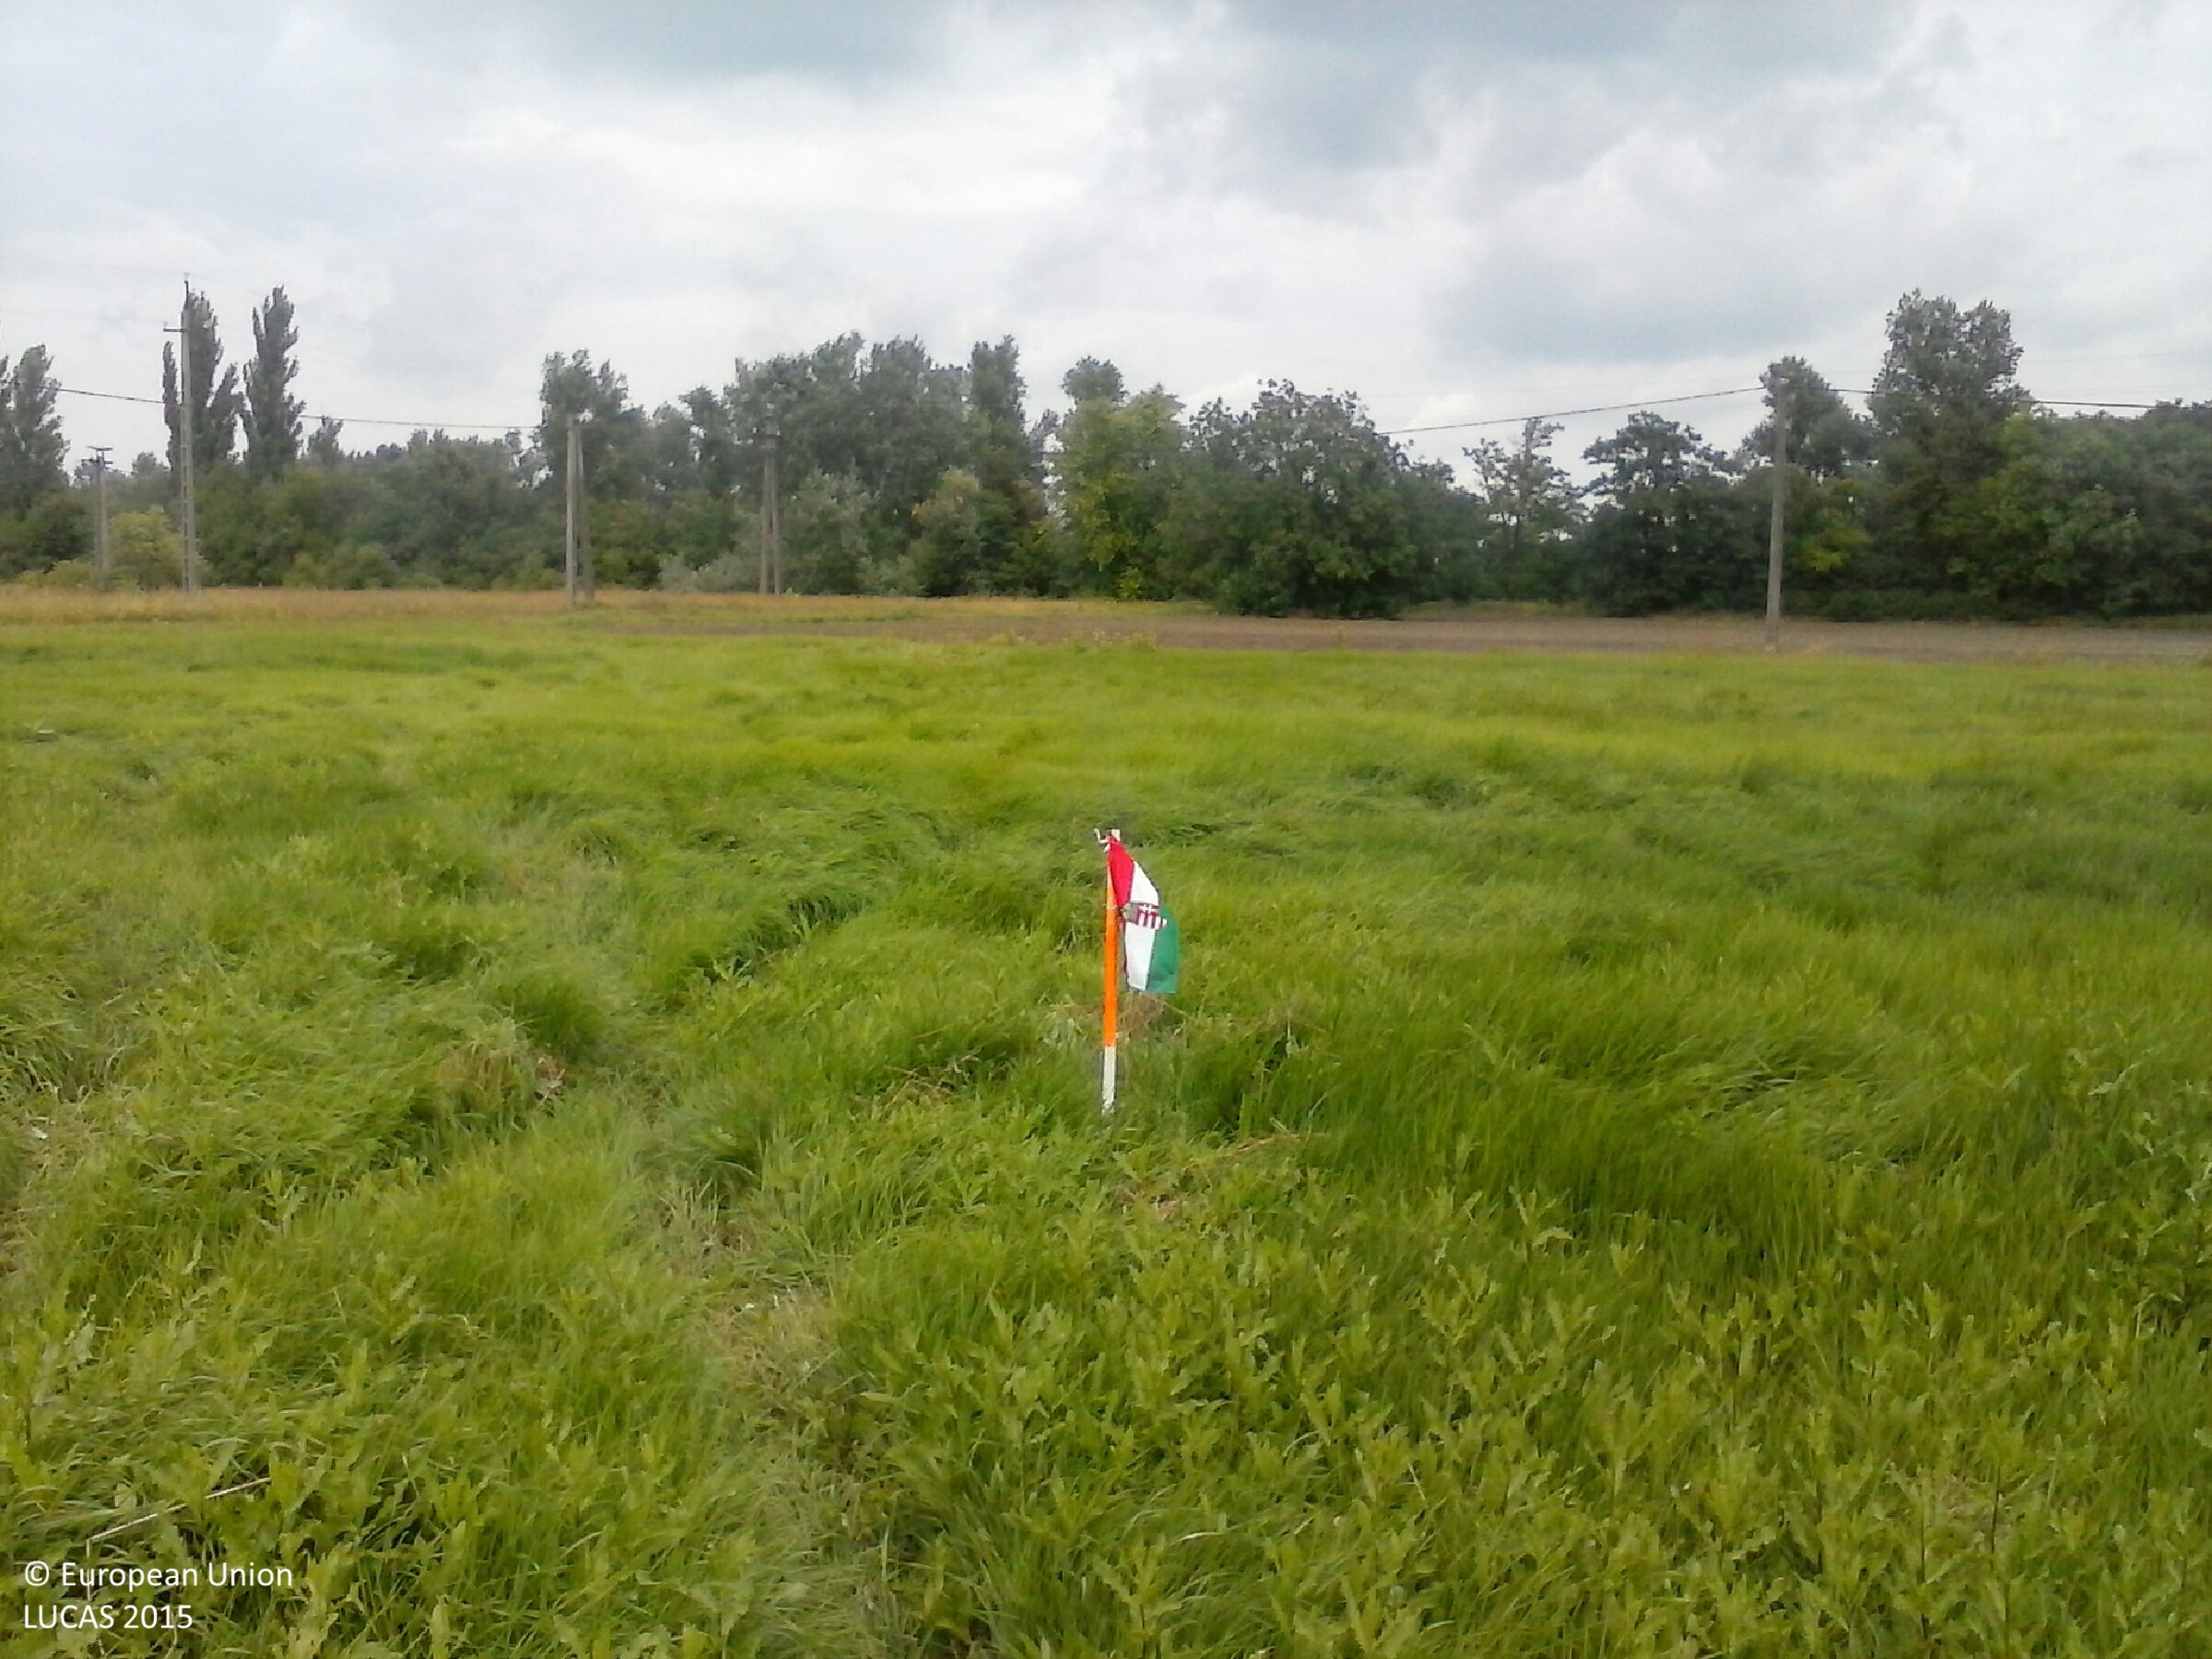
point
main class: Grassland
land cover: Grassland without tree/shrub cover
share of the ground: > 75 %
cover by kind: herbaceous plants 100 %
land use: Agriculture (excluding fallow land and kitchen gardens)
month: June
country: HU
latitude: 46.3672
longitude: 20.0435
